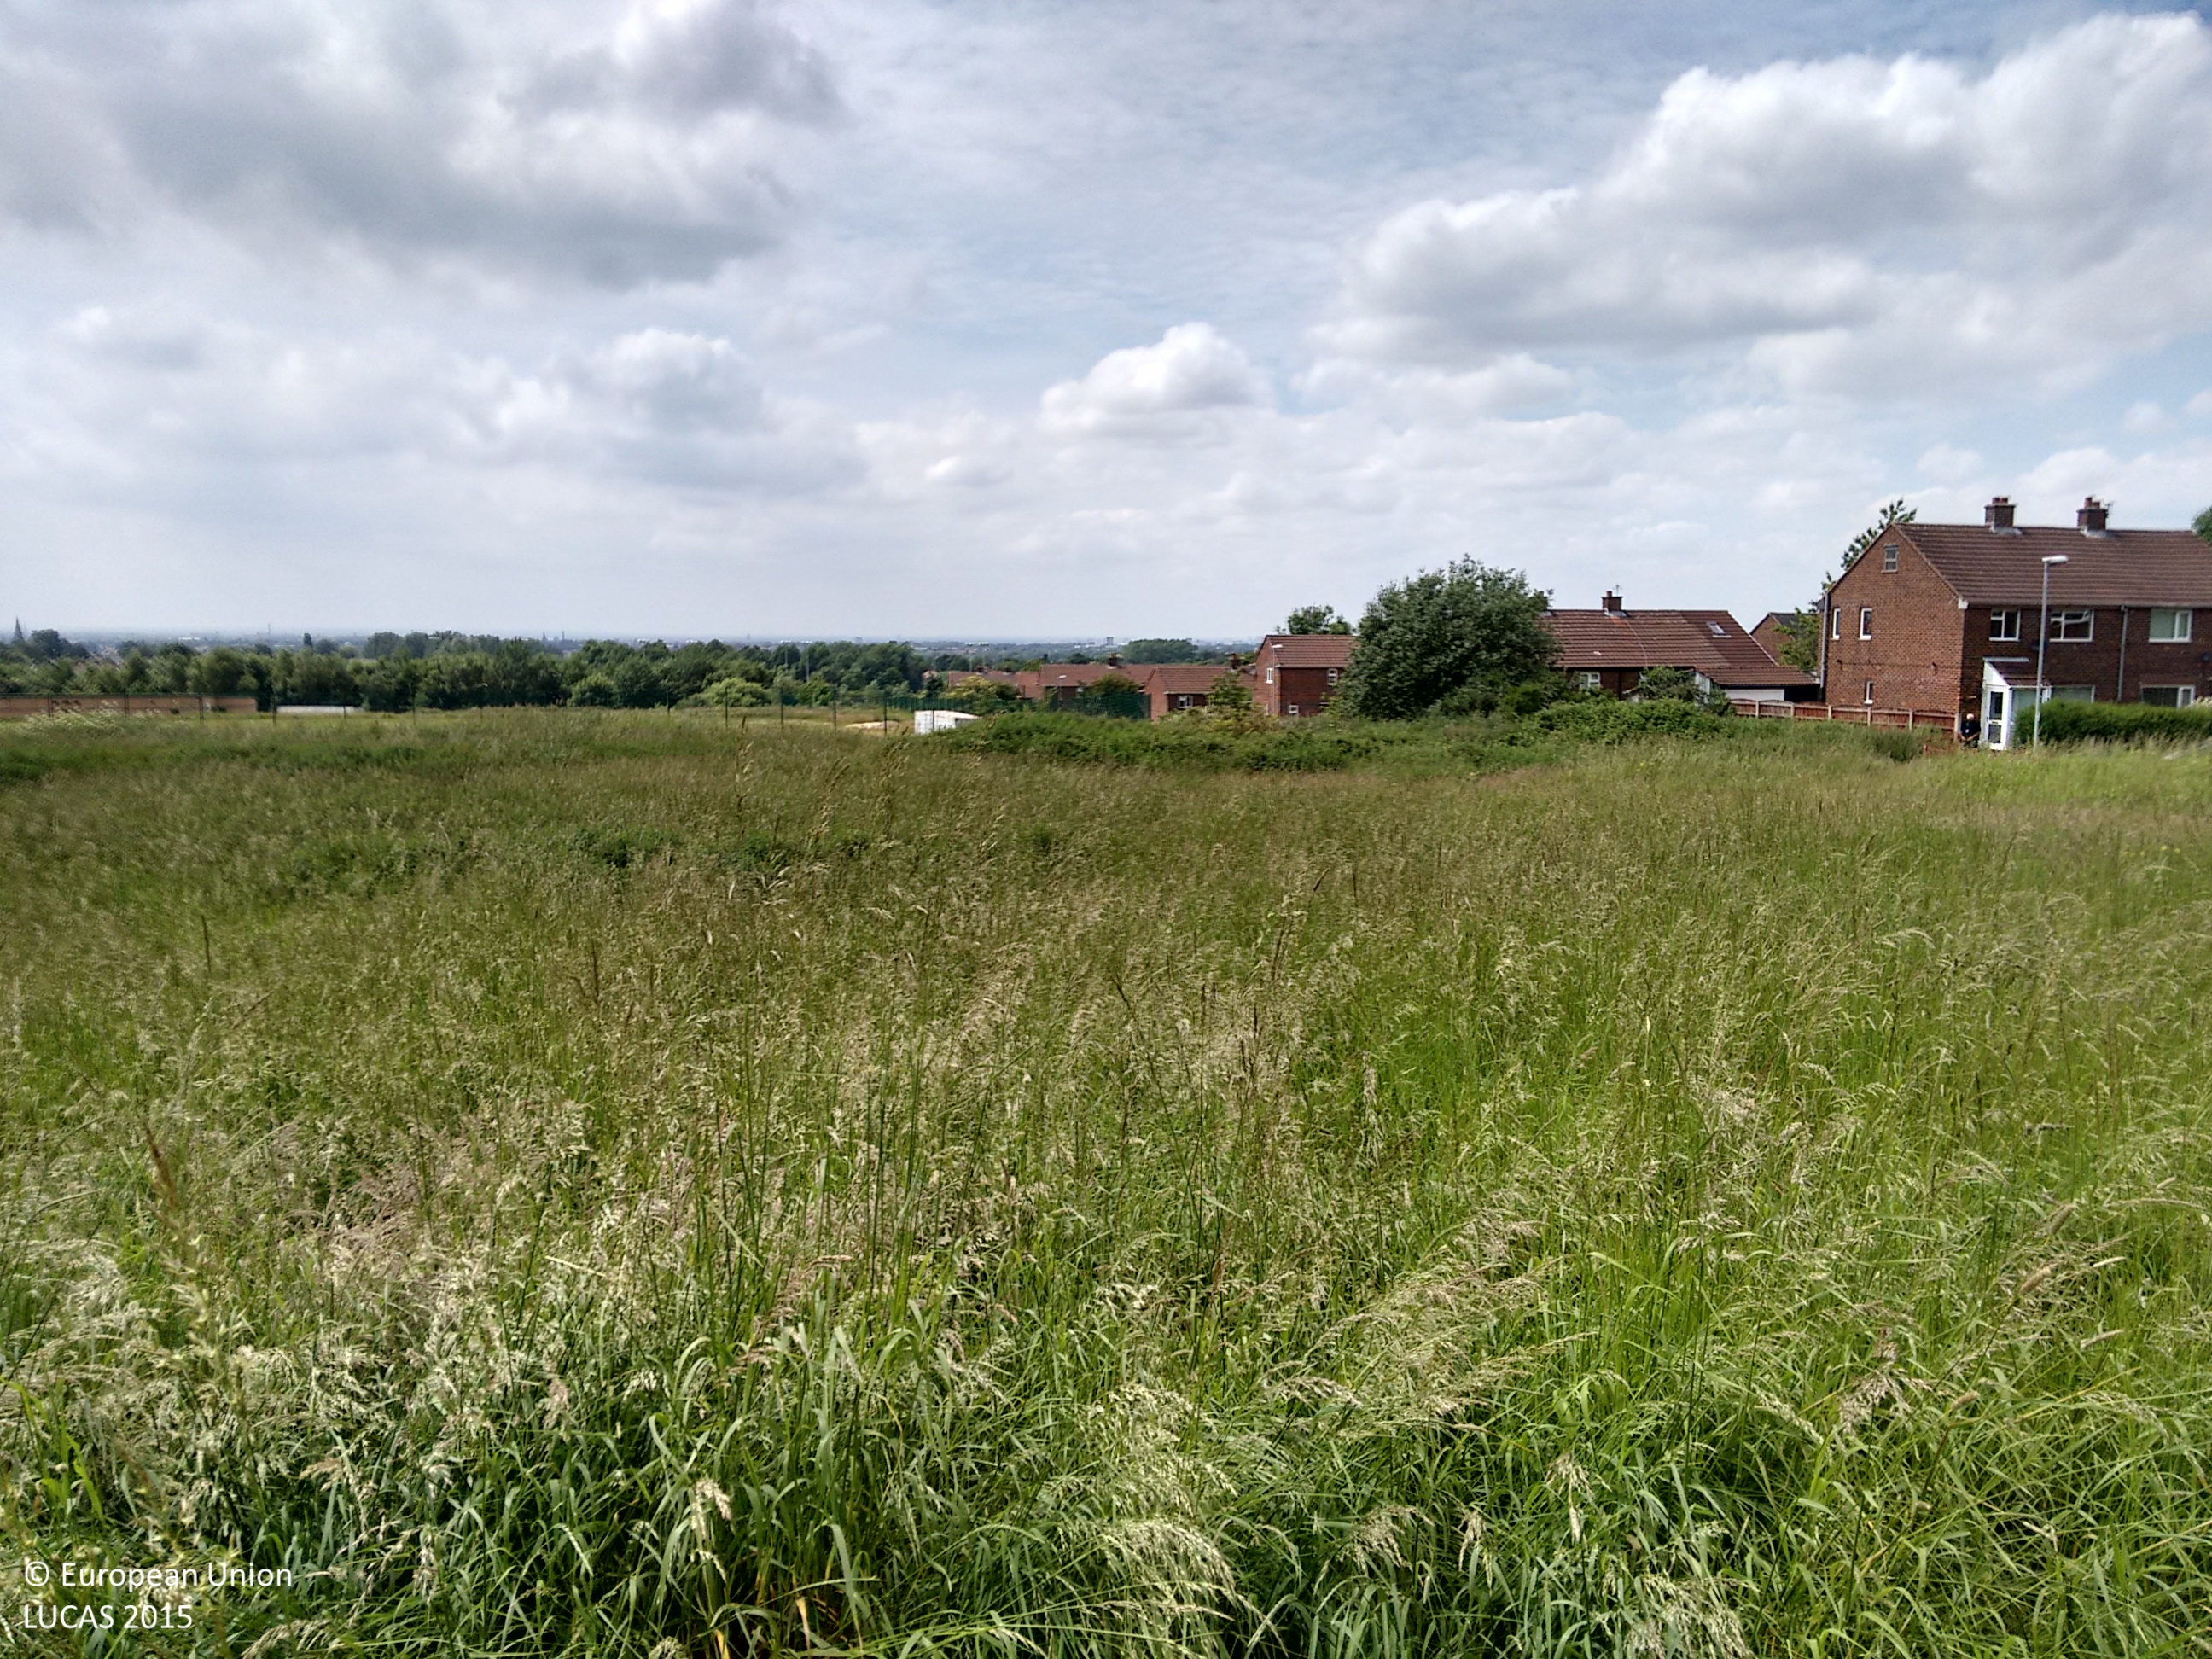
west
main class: Grassland
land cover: Grassland with sparse tree/shrub cover
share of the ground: > 75 %
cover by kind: herbaceous plants 95 %, broadleaved forest trees 5 %
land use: Semi-natural and natural areas not in use
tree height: < 5 m
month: June
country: GB
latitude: 53.4690
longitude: -2.0649
